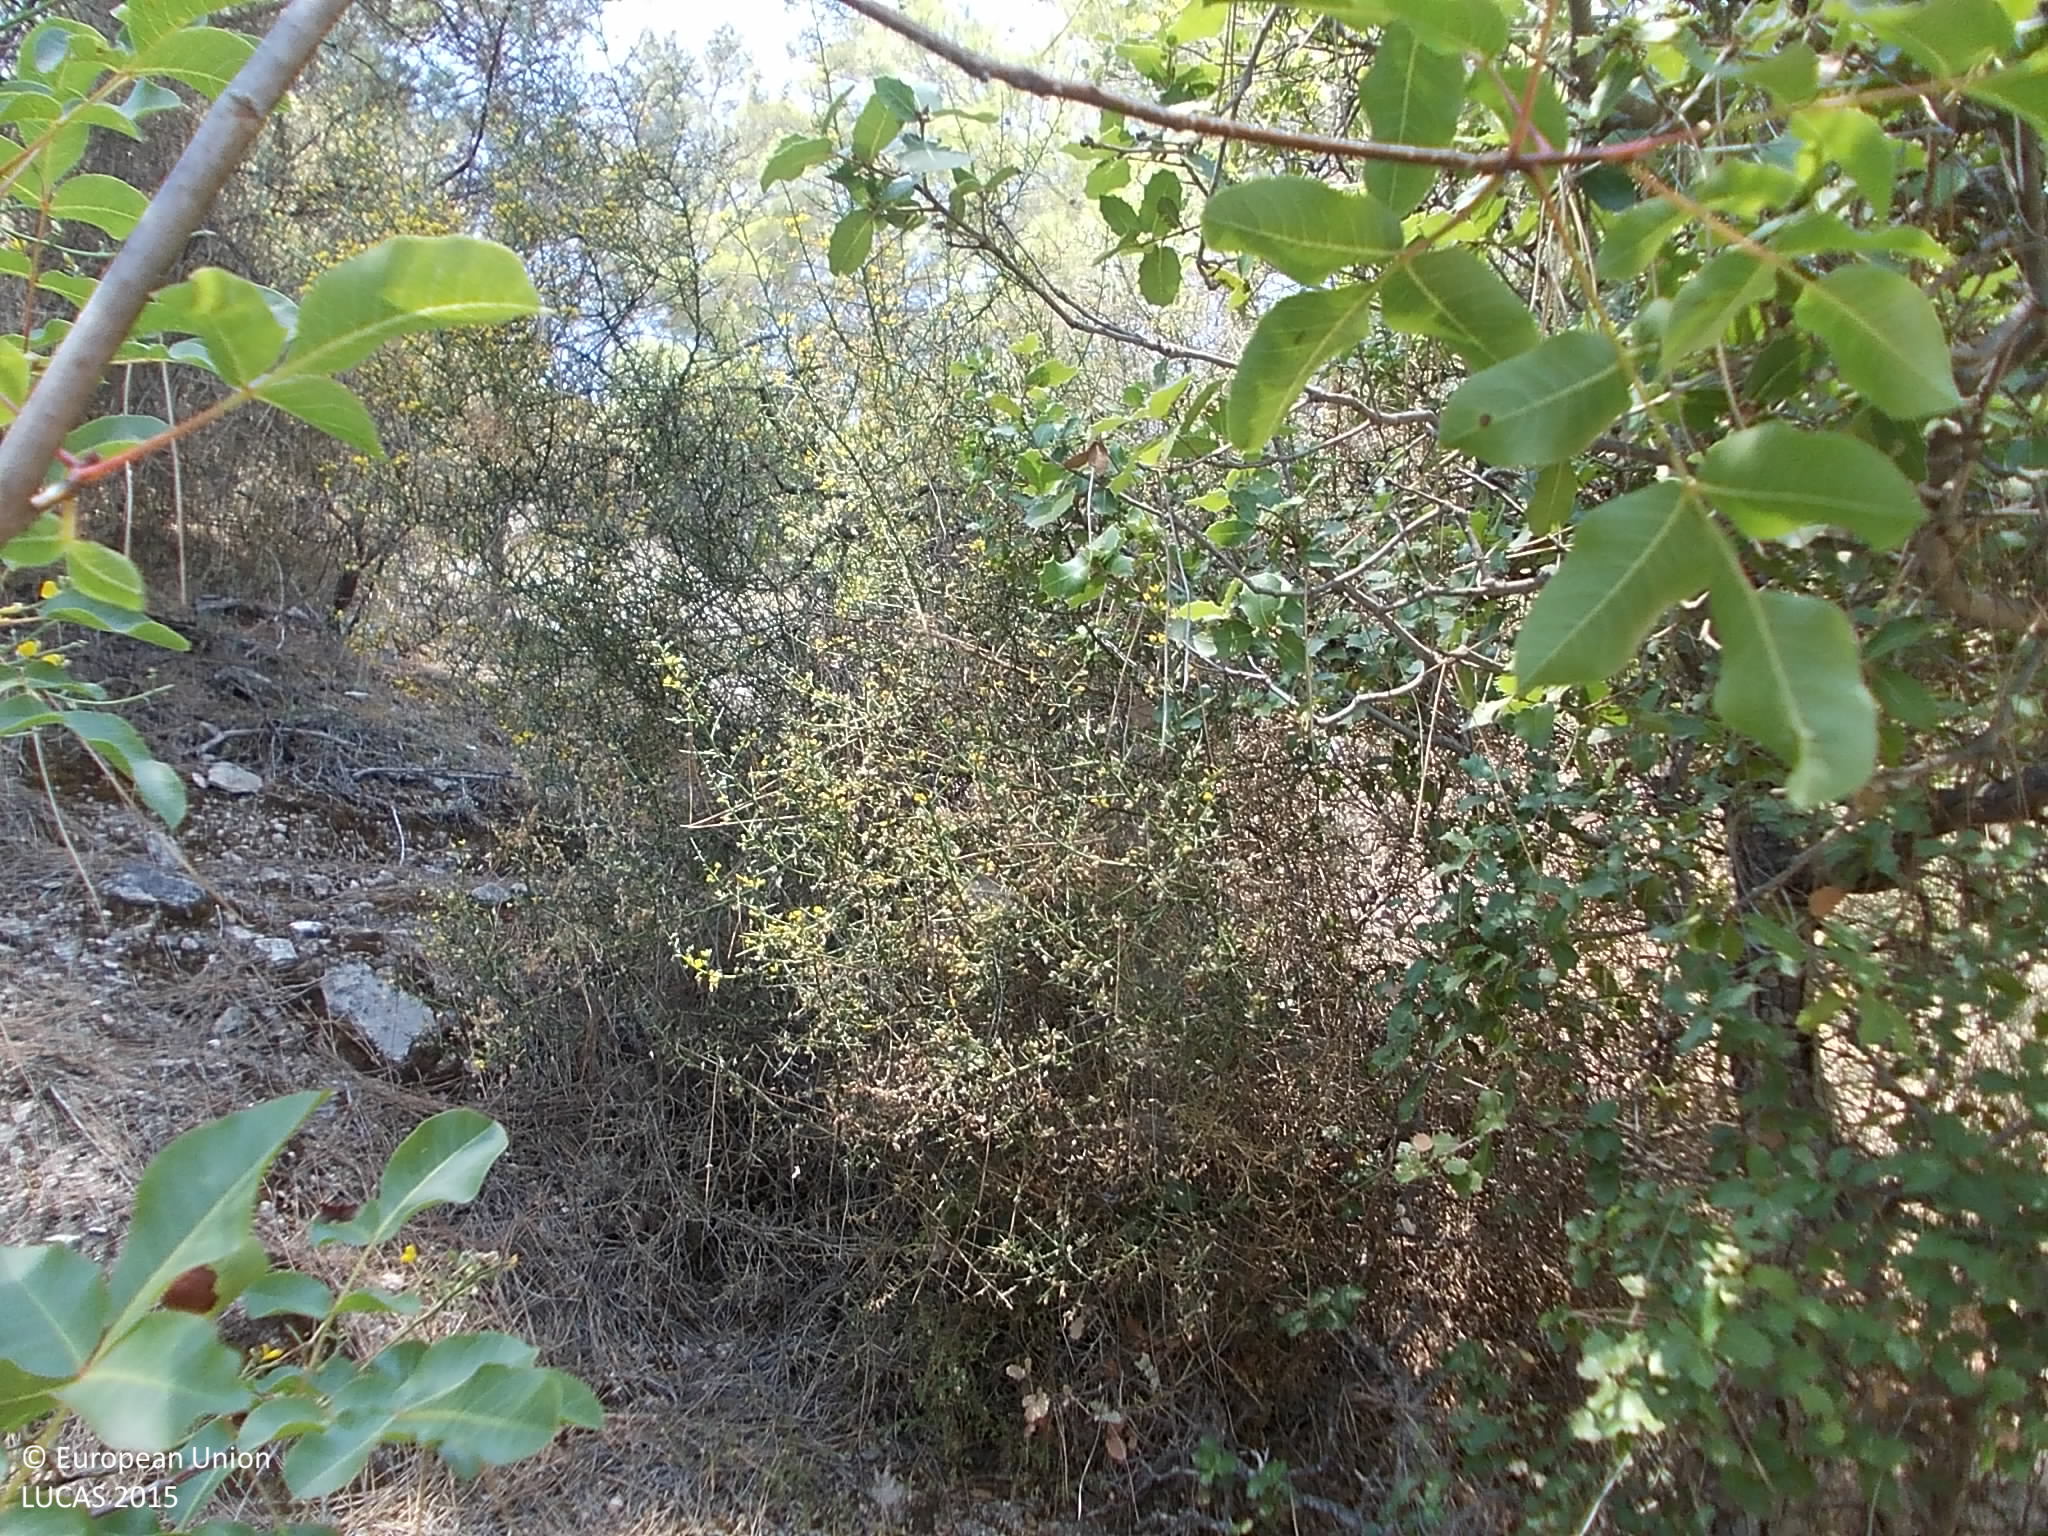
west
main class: Woodland
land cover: Pine dominated coniferous woodland
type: coniferous forest of the mediterranean region
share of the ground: > 75 %
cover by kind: coniferous forest trees 75 %, shrubs 10 %, unconsolidated bare surface 10 %, broadleaved forest trees 5 %
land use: Semi-natural and natural areas not in use
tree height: > 5 m
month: July
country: CY
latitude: 34.7544
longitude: 32.7132
